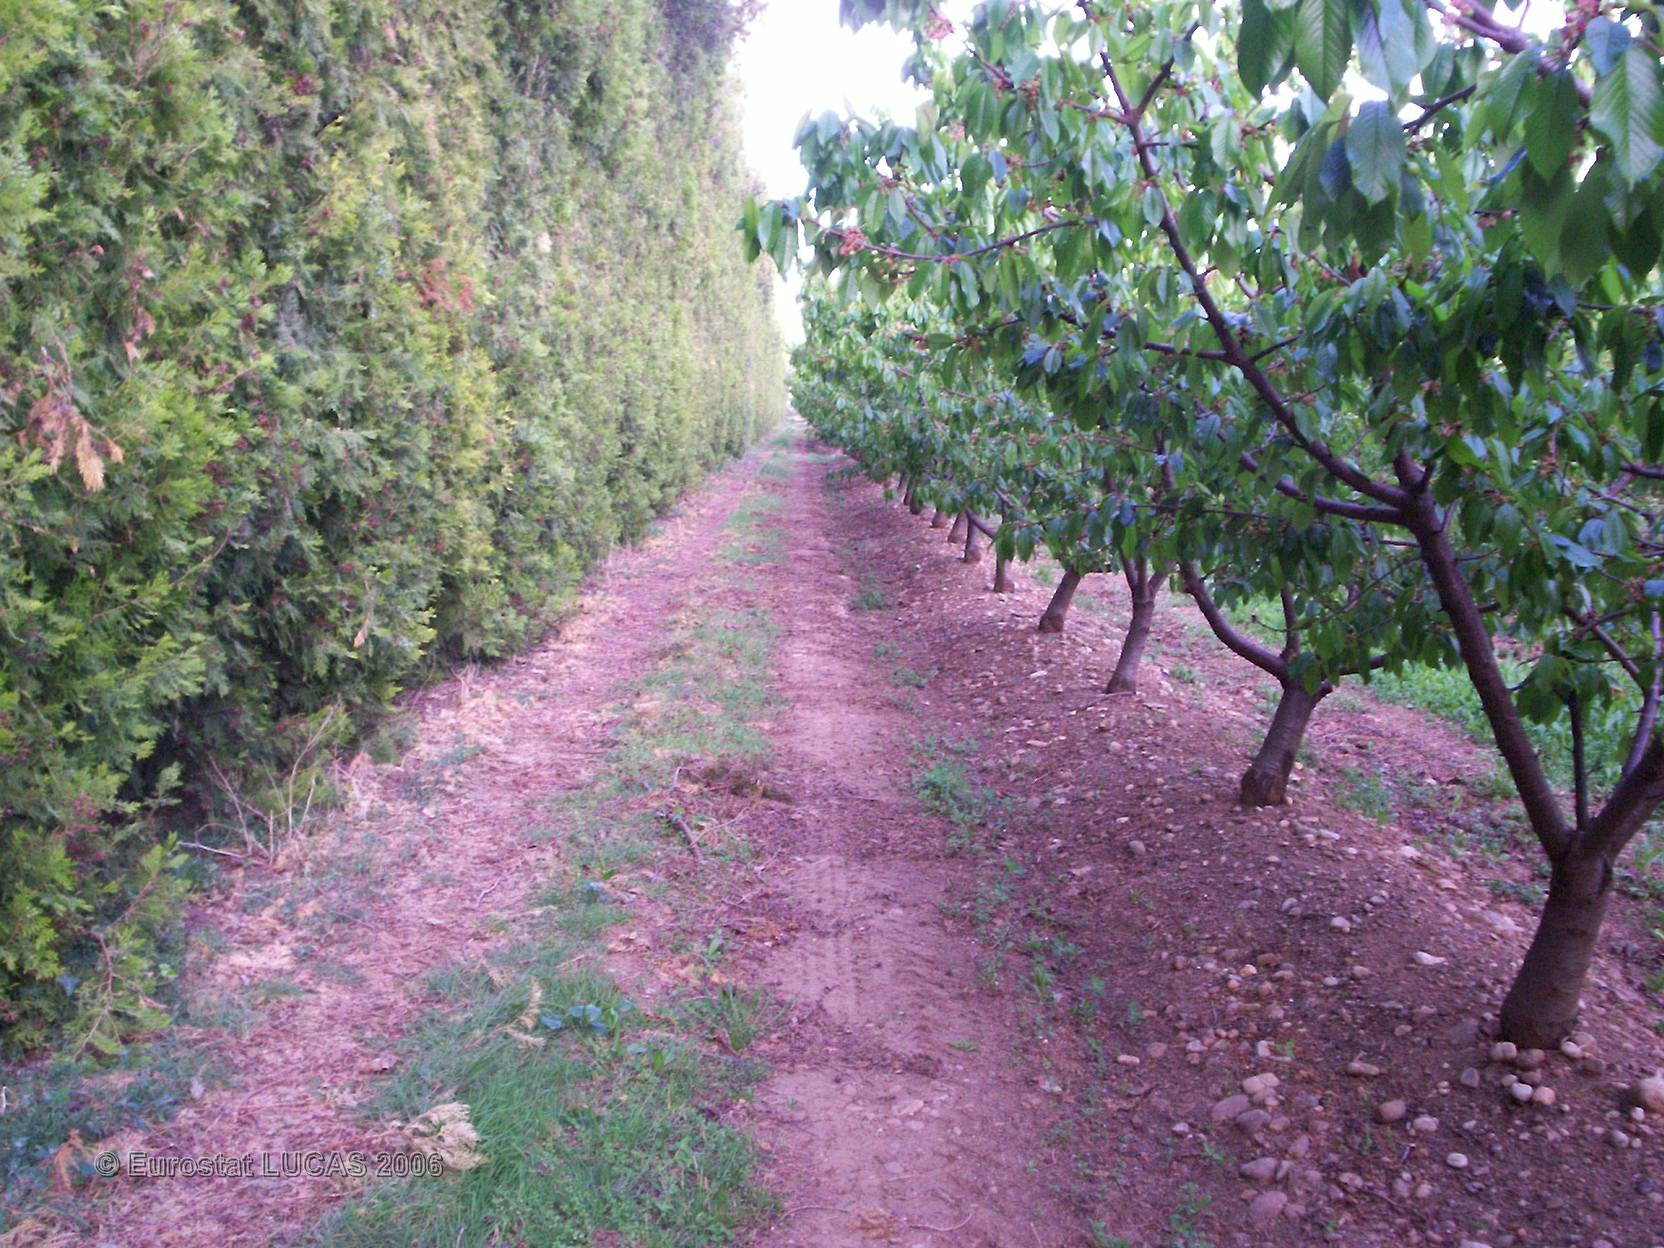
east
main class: Cropland
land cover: Cherry fruit
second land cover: Grassland with sparse tree/shrub cover
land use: Agriculture (excluding fallow land and kitchen gardens)
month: April
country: FR
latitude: 43.6500
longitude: 4.9634
